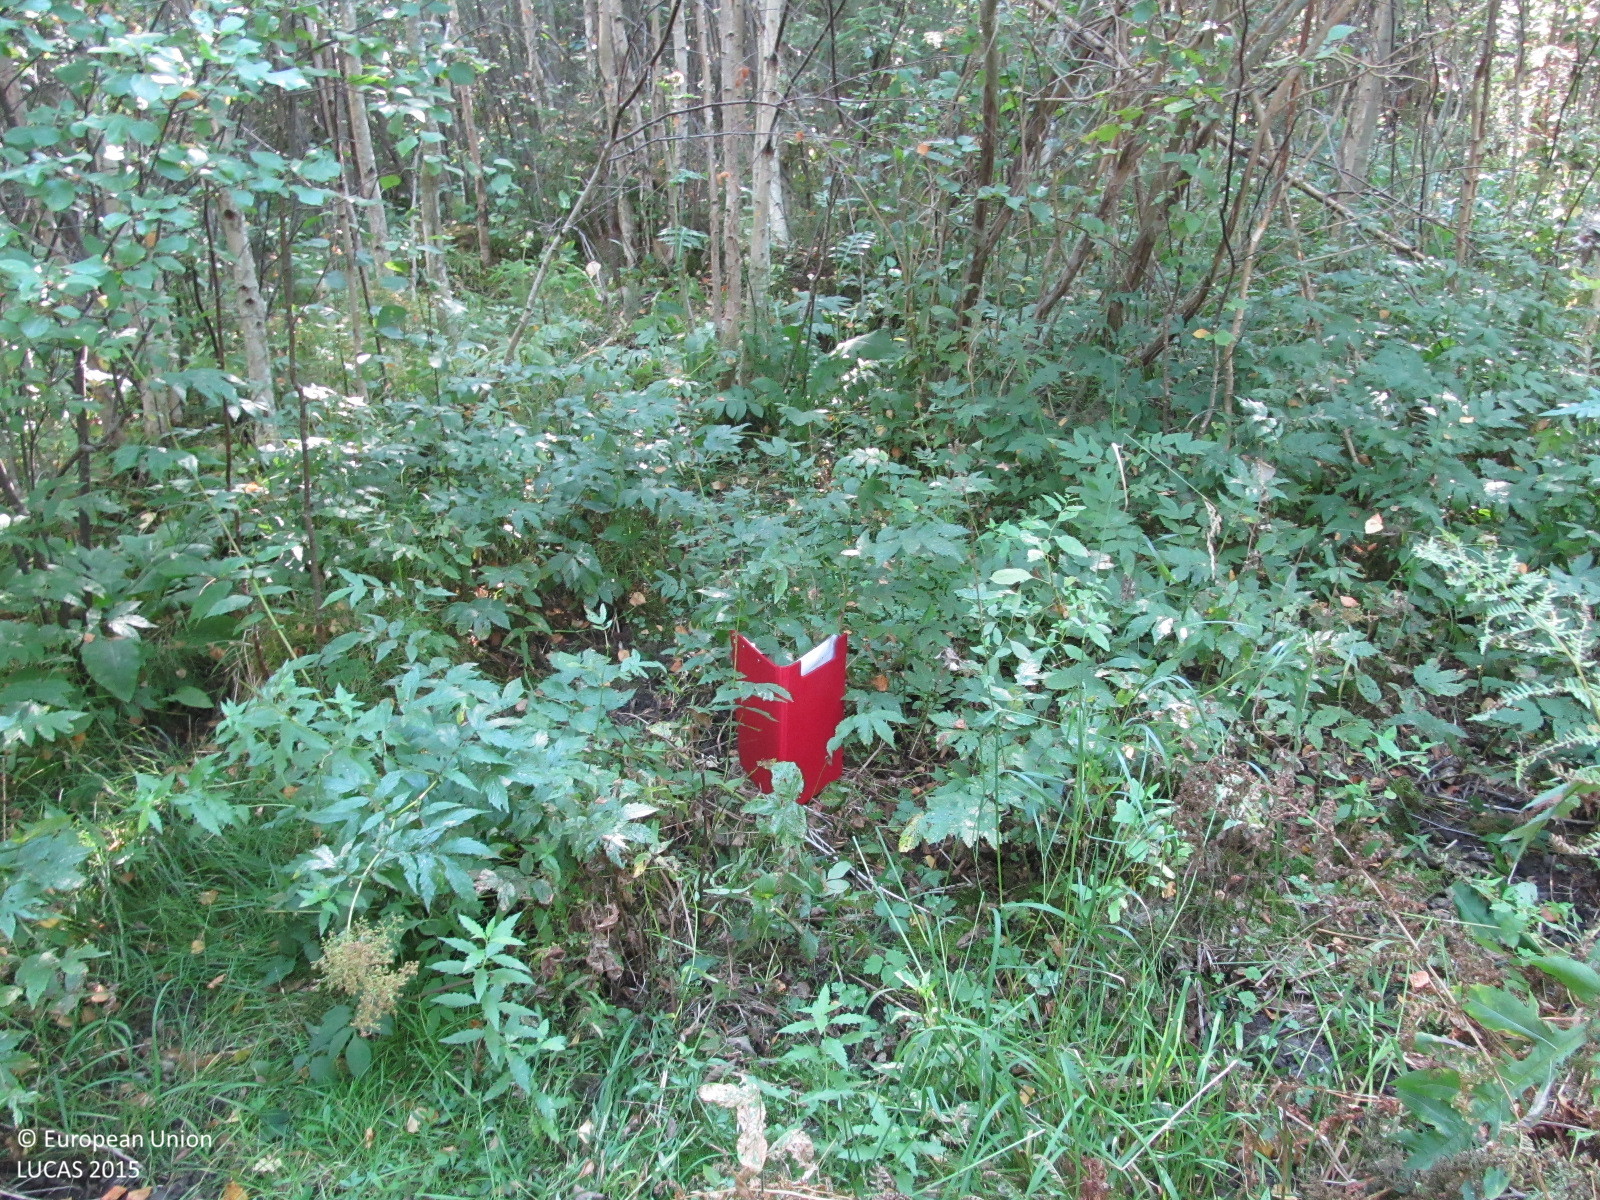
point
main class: Woodland
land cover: Broadleaved woodland
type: non-riverine alder, birch or aspen forest
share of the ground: > 75 %
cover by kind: broadleaved forest trees 80 %, herbaceous plants 20 %
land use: Forestry
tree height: < 5 m
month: August
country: LT
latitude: 55.7300
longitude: 23.1124
